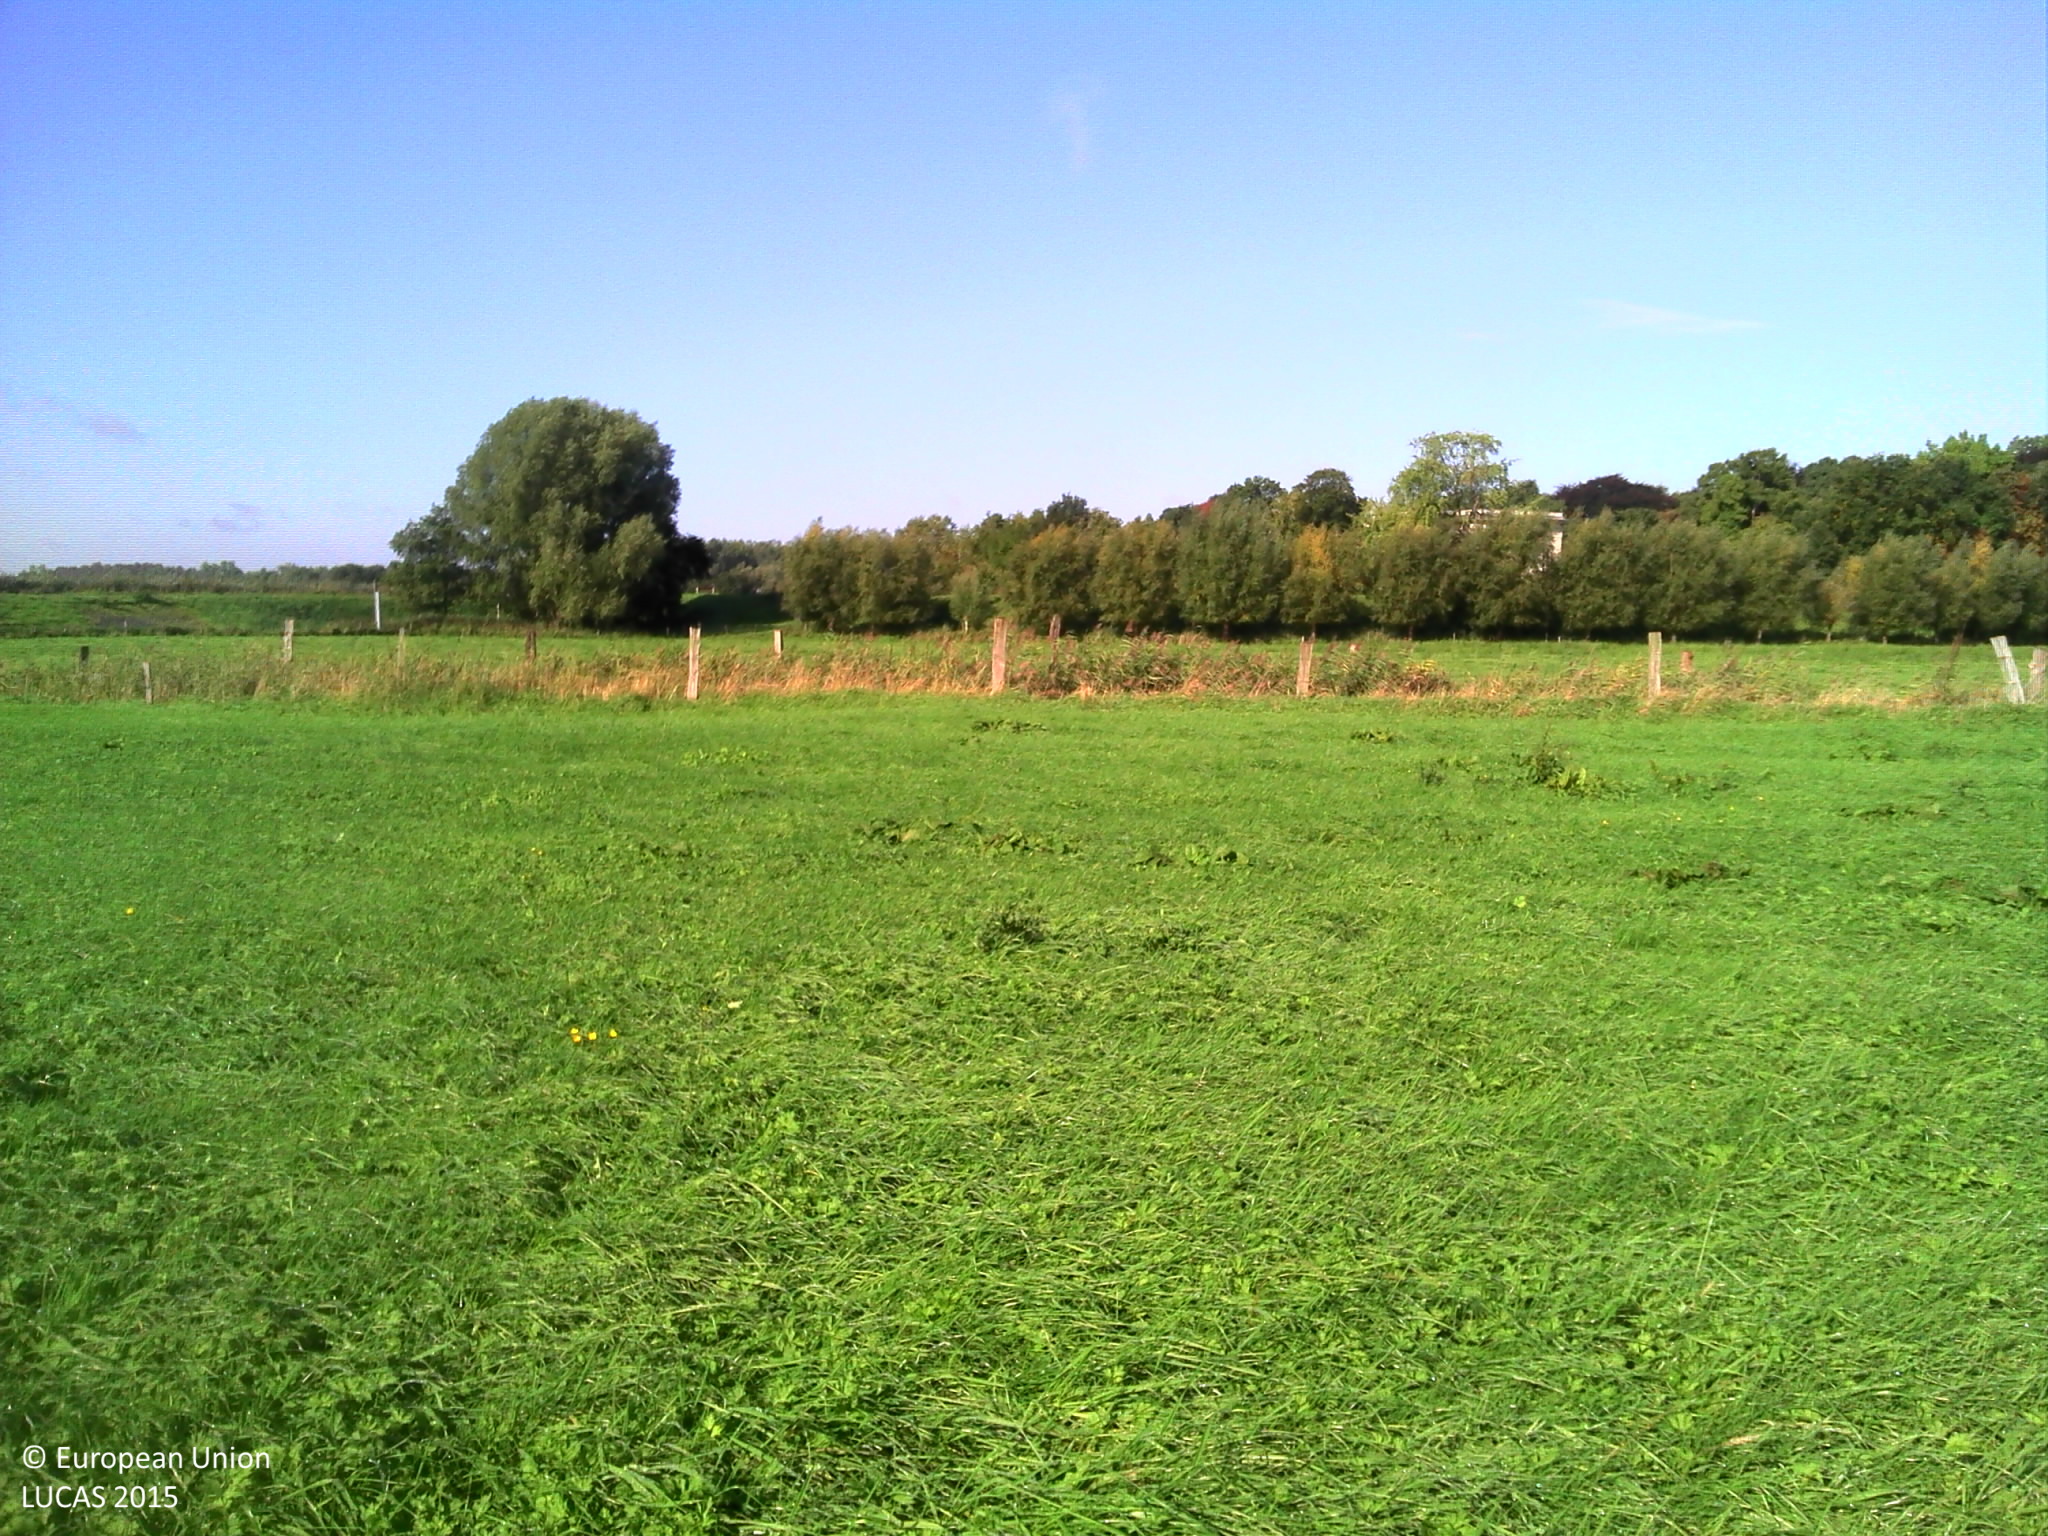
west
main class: Grassland
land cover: Grassland without tree/shrub cover
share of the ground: > 75 %
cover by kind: herbaceous plants 100 %
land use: Agriculture (excluding fallow land and kitchen gardens)
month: September
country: BE
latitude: 51.1174
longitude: 4.5530
